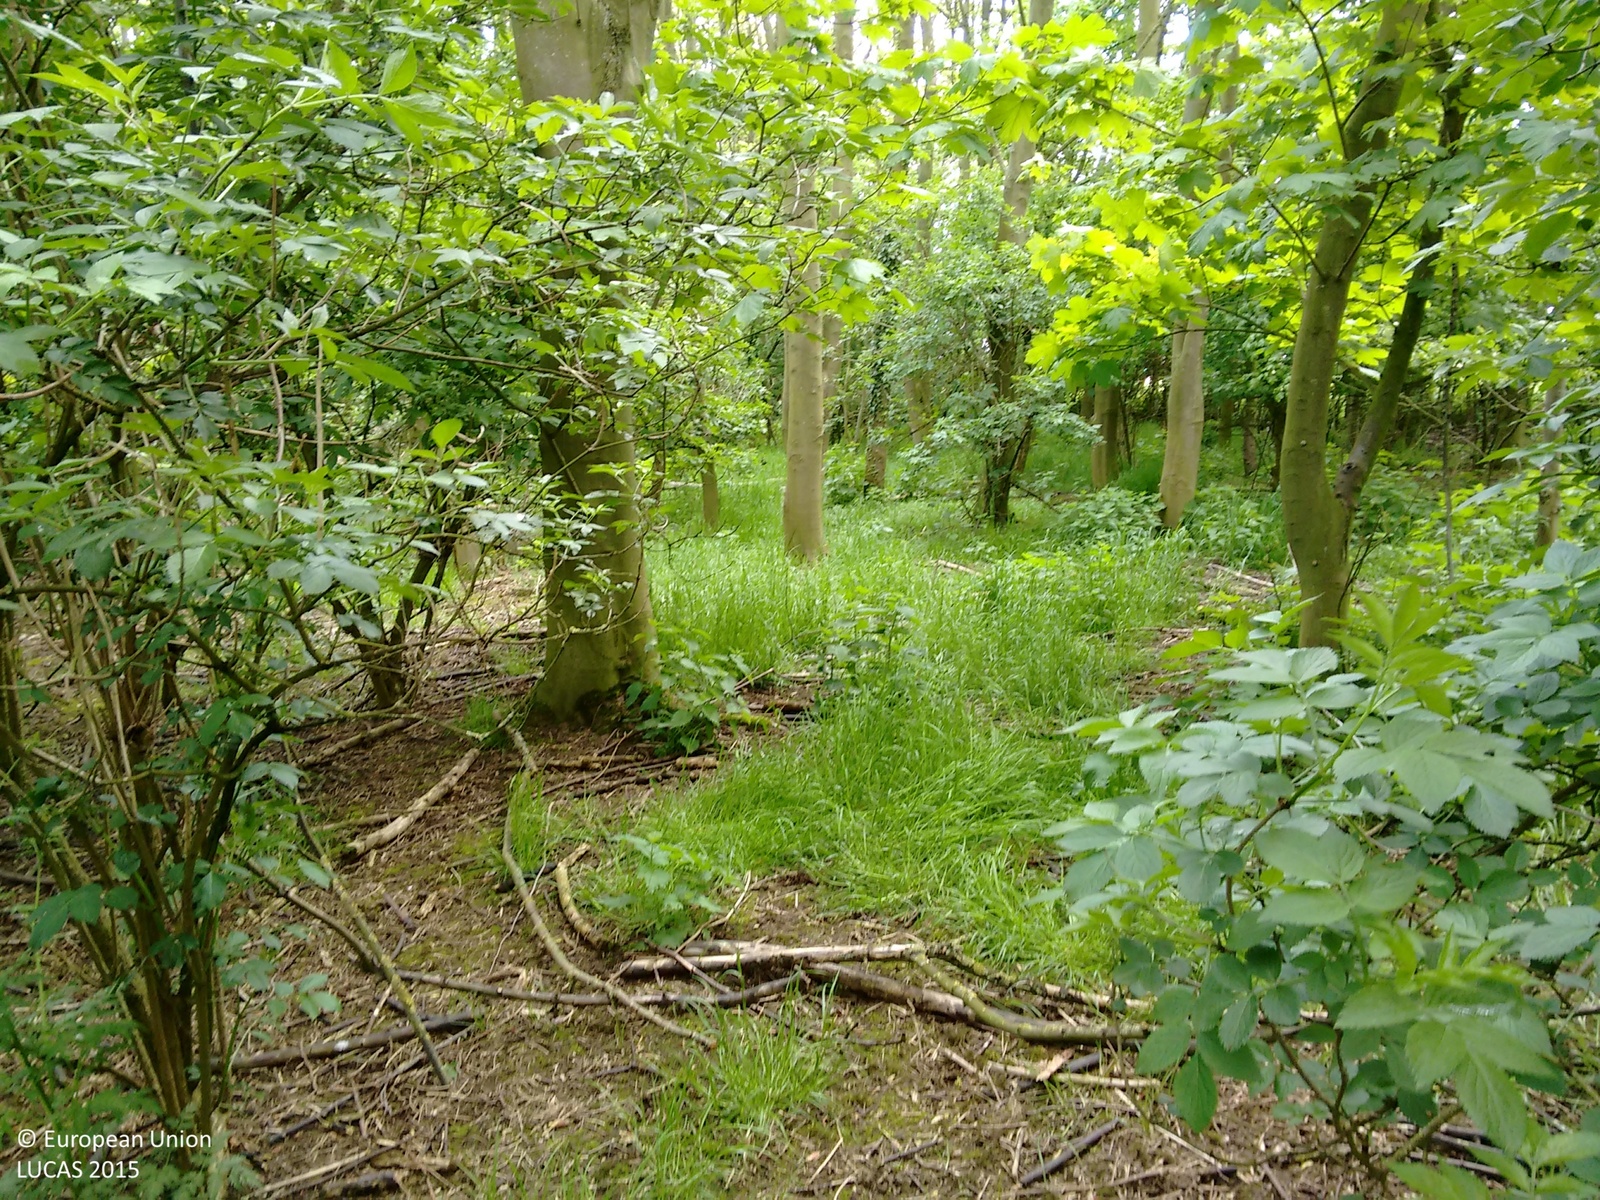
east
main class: Woodland
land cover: Broadleaved woodland
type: mesophytic deciduous forest
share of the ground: > 75 %
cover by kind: broadleaved forest trees 100 %
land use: Agriculture (excluding fallow land and kitchen gardens)
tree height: > 5 m
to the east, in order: Broadleaved woodland; Grassland without tree/shrub cover; Tracks; Grassland without tree/shrub cover; Clovers; Other bare soil
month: May
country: GB
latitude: 53.1005
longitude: 0.2777
